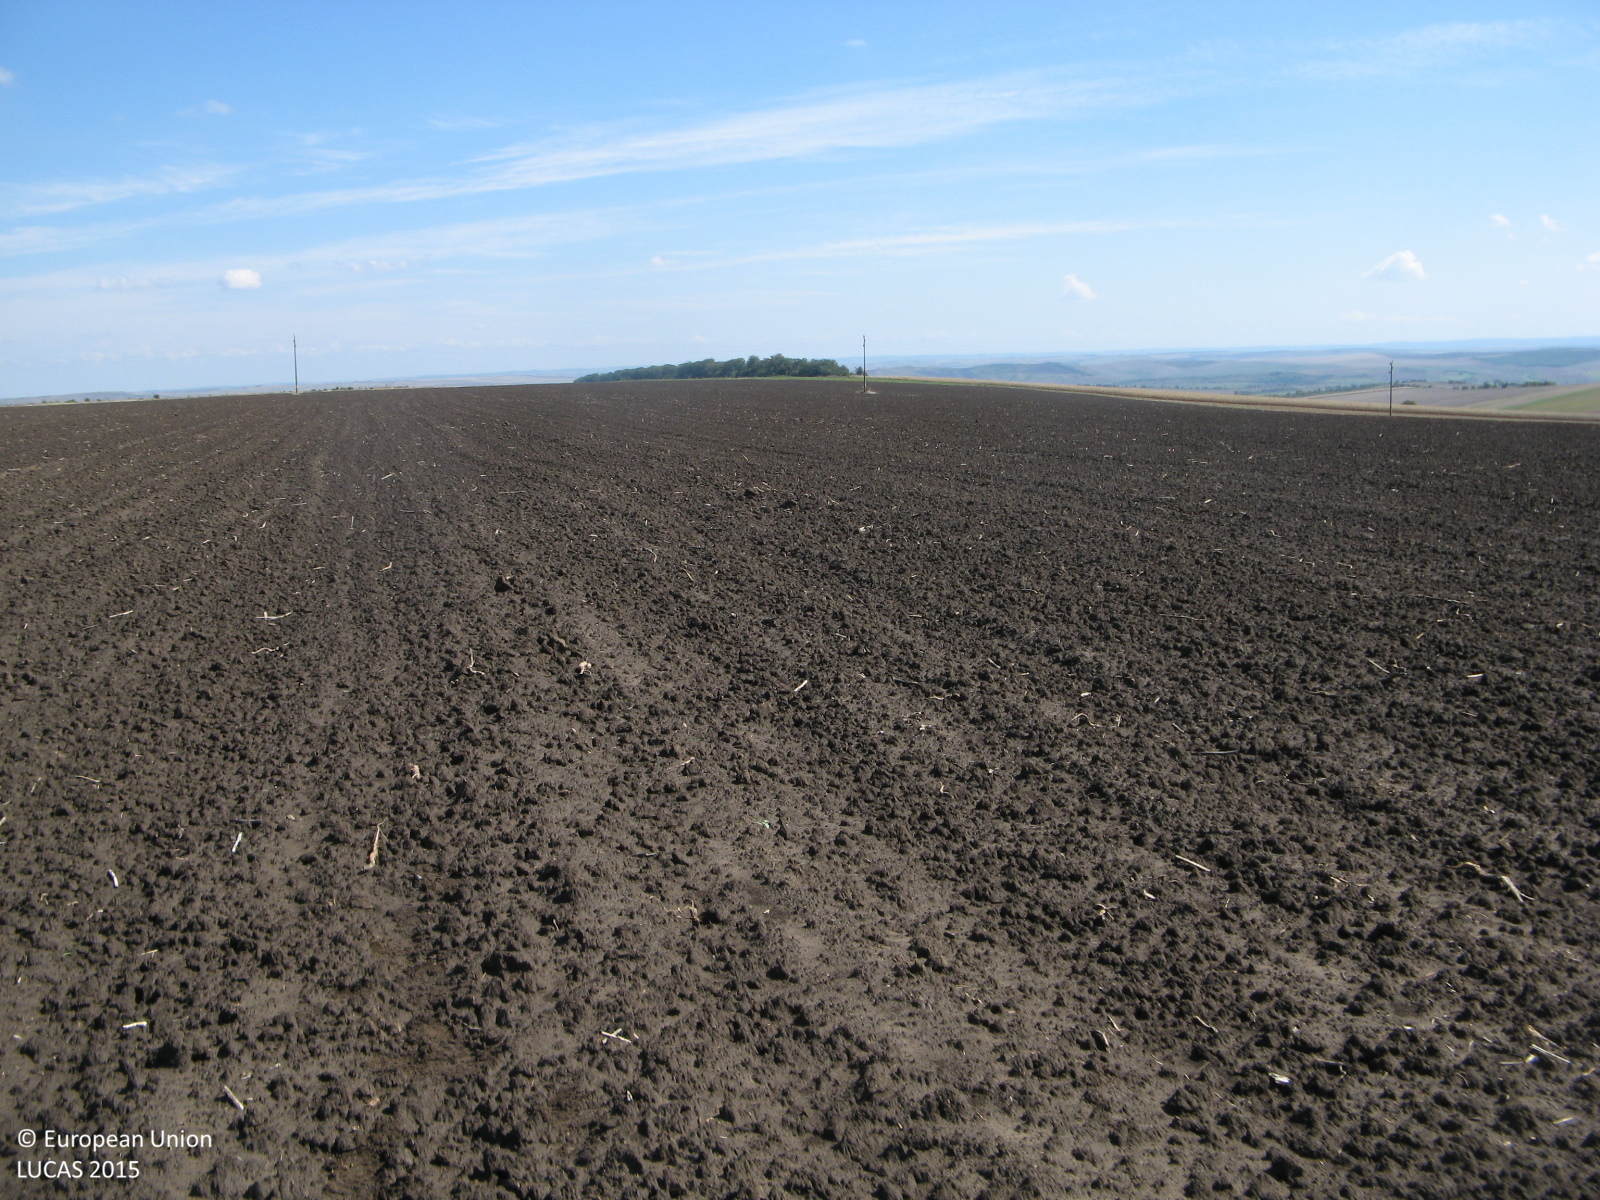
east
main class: Cropland
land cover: Rape and turnip rape
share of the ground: < 10 %
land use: Agriculture (excluding fallow land and kitchen gardens)
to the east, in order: Rape and turnip rape
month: September
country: BG
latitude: 43.4899
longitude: 25.3748
